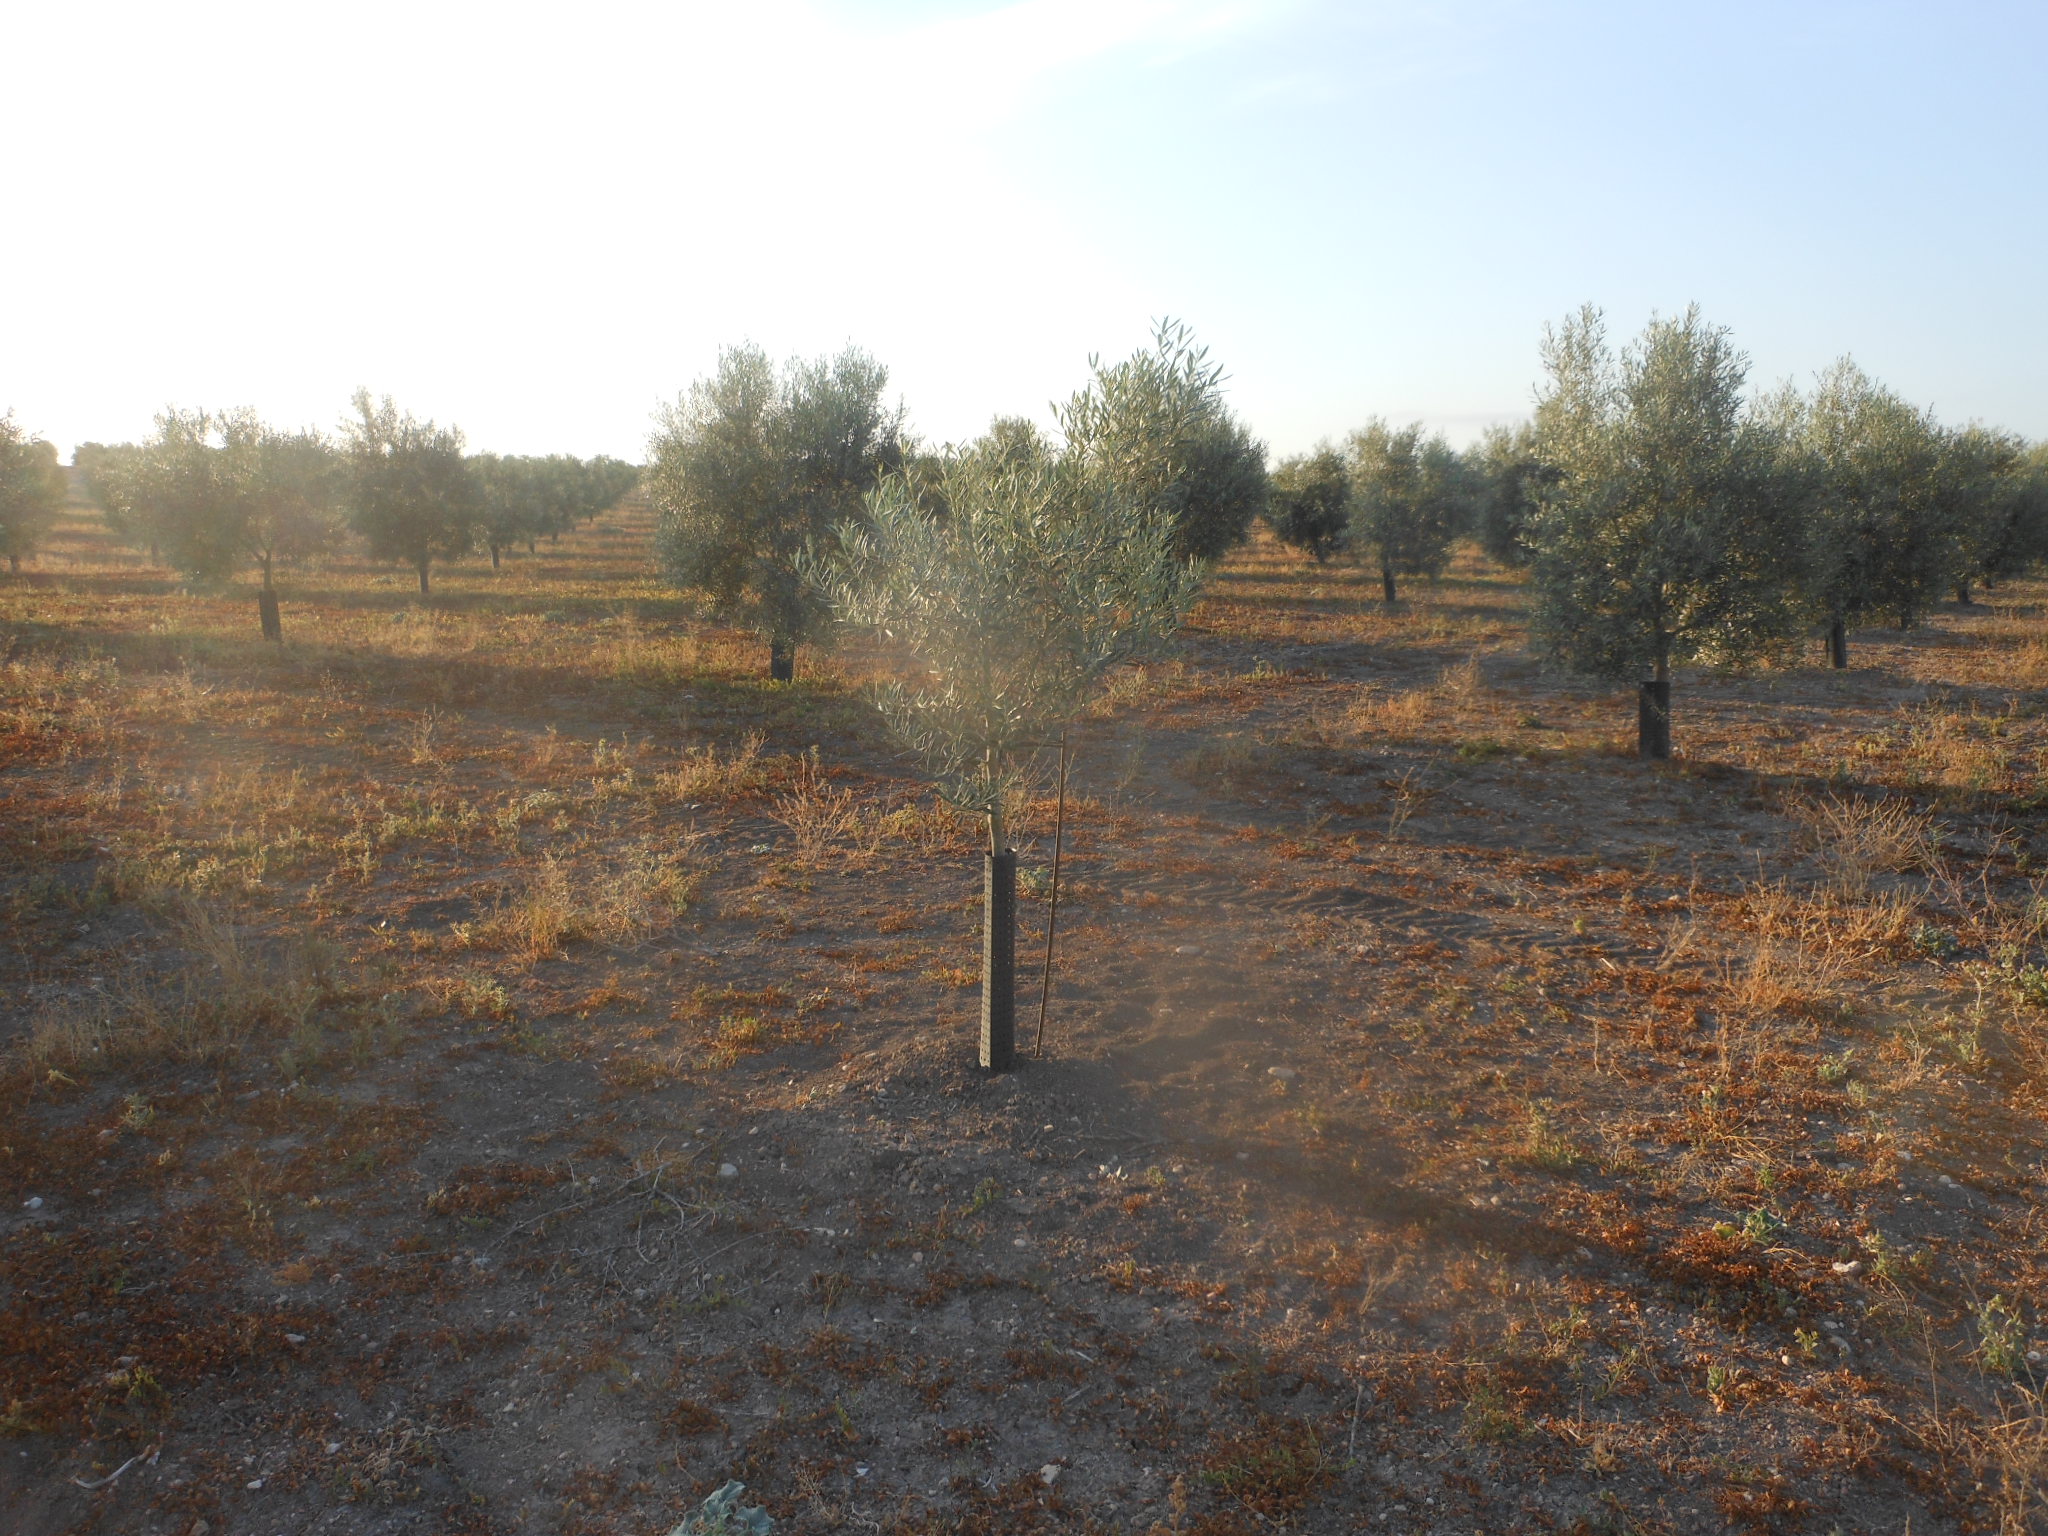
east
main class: Cropland
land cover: Olive groves
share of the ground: 25 - 50 %
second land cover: Spontaneously vegetated surfaces
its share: 10 - 25 %
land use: Agriculture (excluding fallow land and kitchen gardens)
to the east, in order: Olive groves; Spontaneously vegetated surfaces; Grass margins; Tracks
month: June
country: ES
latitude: 37.2587
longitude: -5.0599
